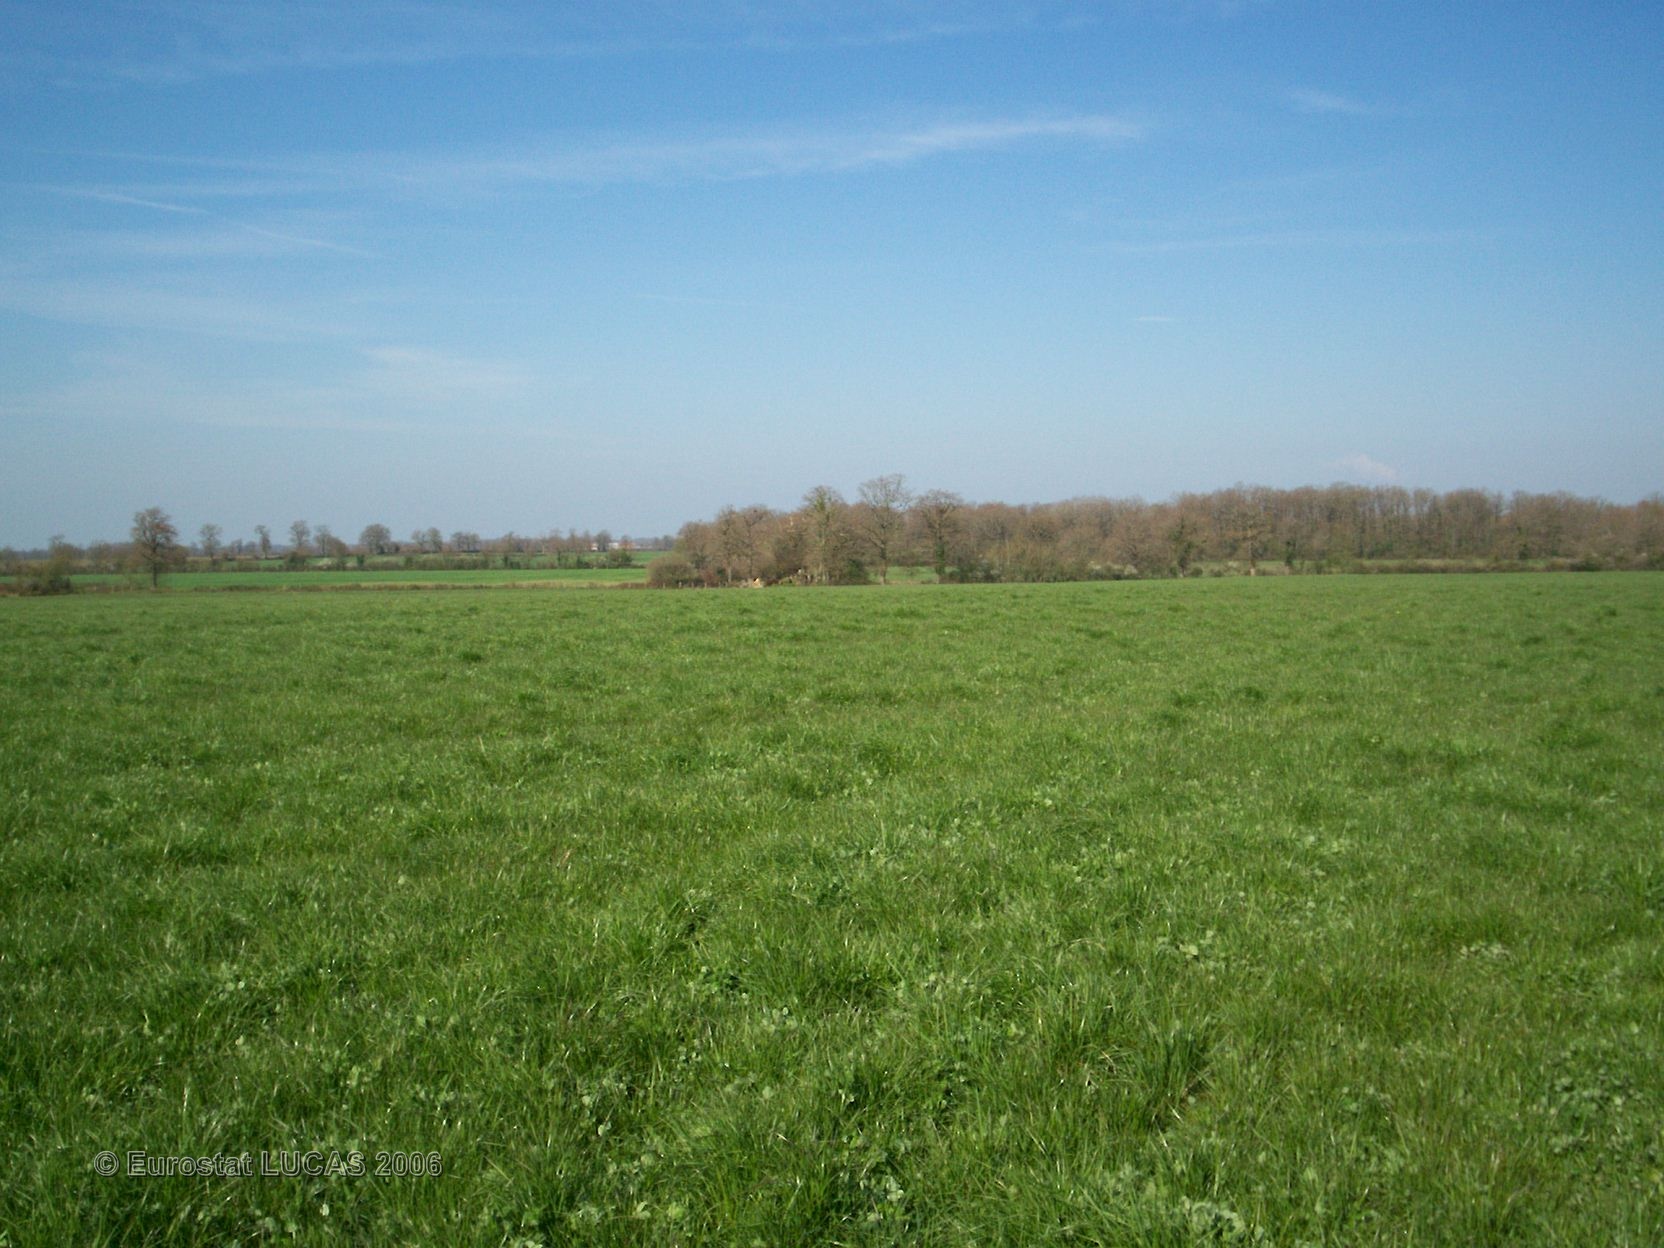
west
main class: Grassland
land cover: Grassland without tree/shrub cover
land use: Agriculture (excluding fallow land and kitchen gardens)
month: April
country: FR
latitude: 46.3588
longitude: 1.0848
